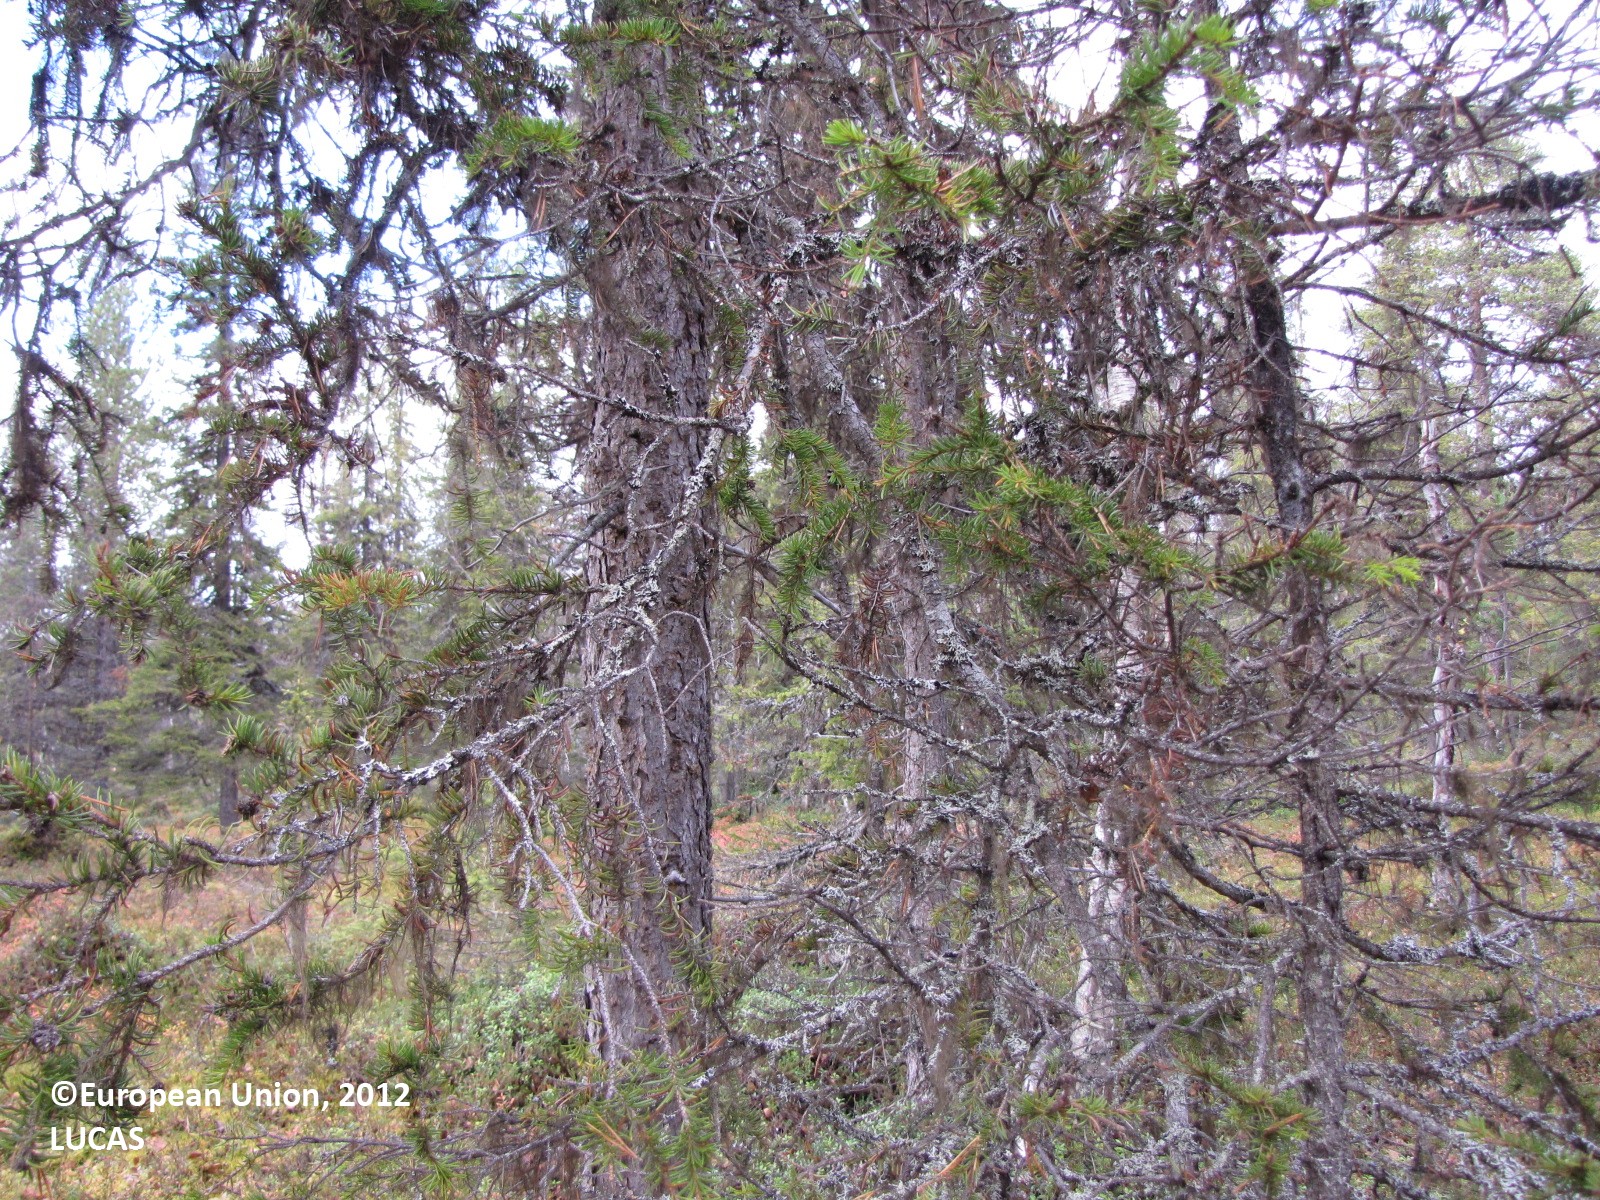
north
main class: Woodland
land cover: Pine dominated mixed woodland
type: boreal forest
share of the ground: 25 - 50 %
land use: Forestry
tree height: > 5 m
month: September
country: FI
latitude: 67.9046
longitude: 24.2430
